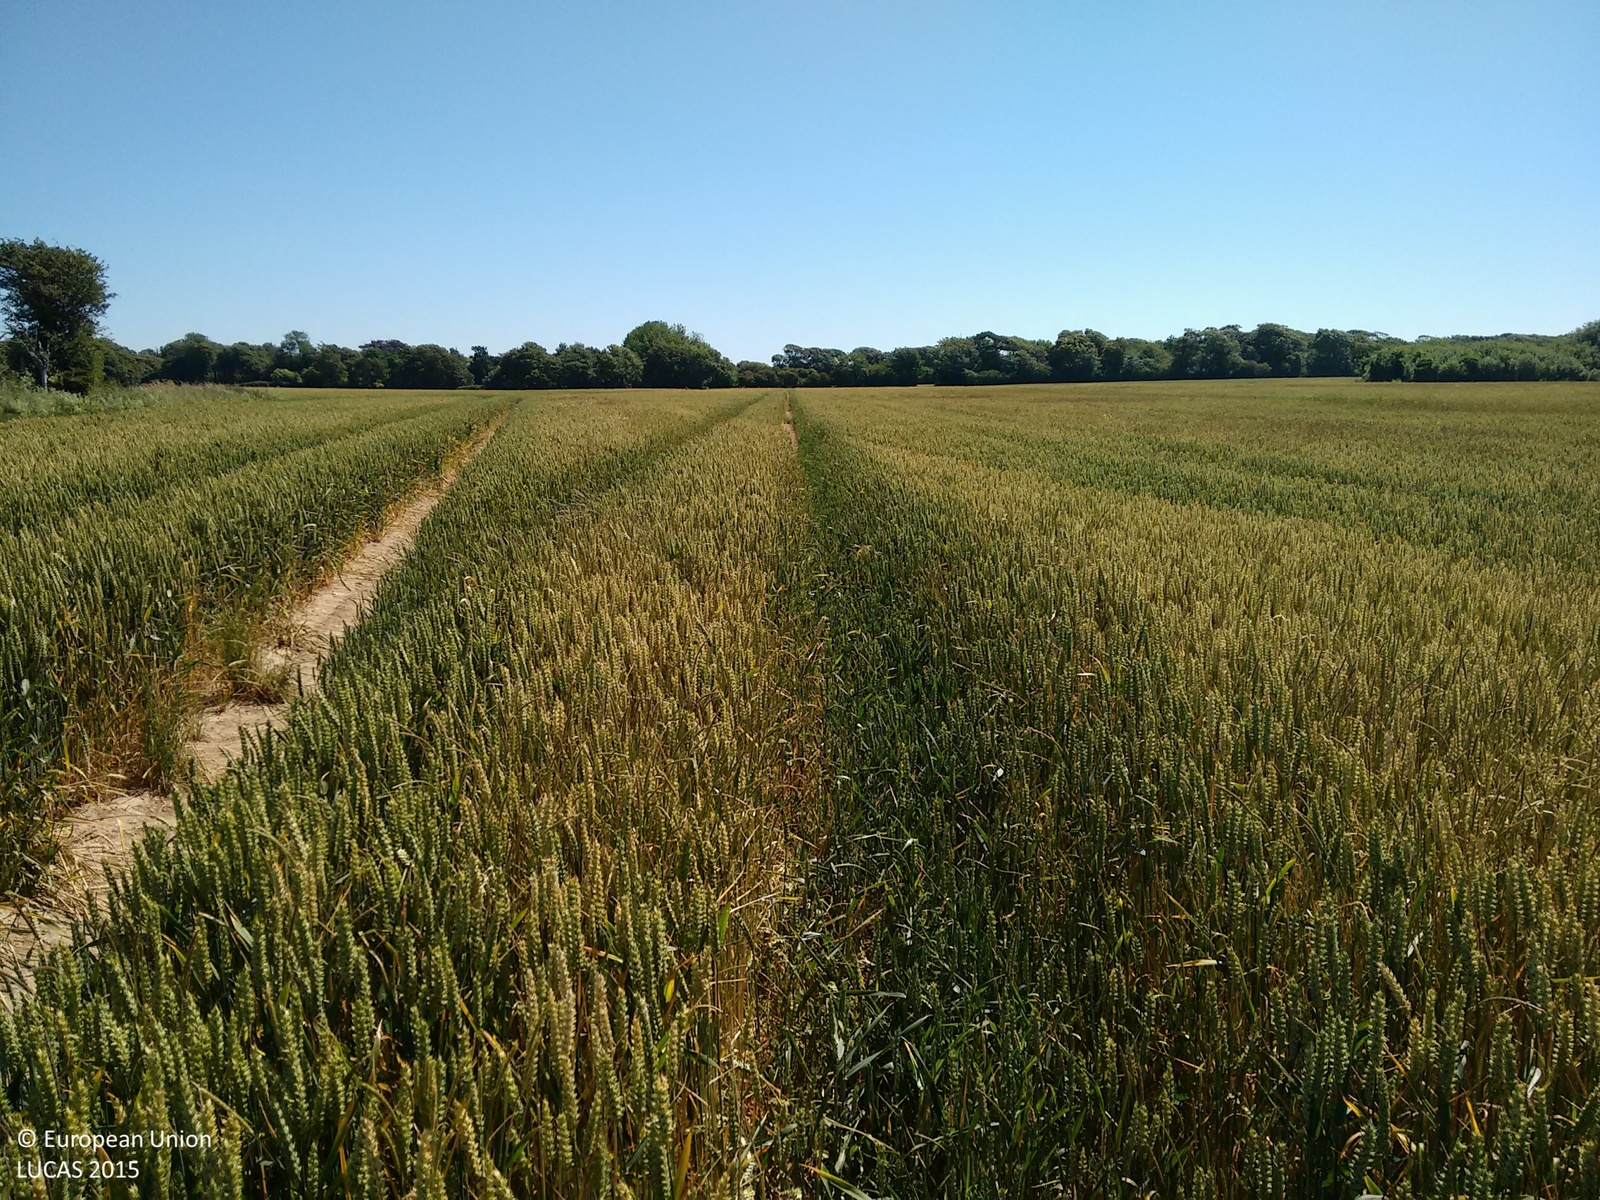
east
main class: Cropland
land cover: Common wheat
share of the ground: > 75 %
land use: Agriculture (excluding fallow land and kitchen gardens)
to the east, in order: Common wheat
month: June
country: GB
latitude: 50.8098
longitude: -0.4400
